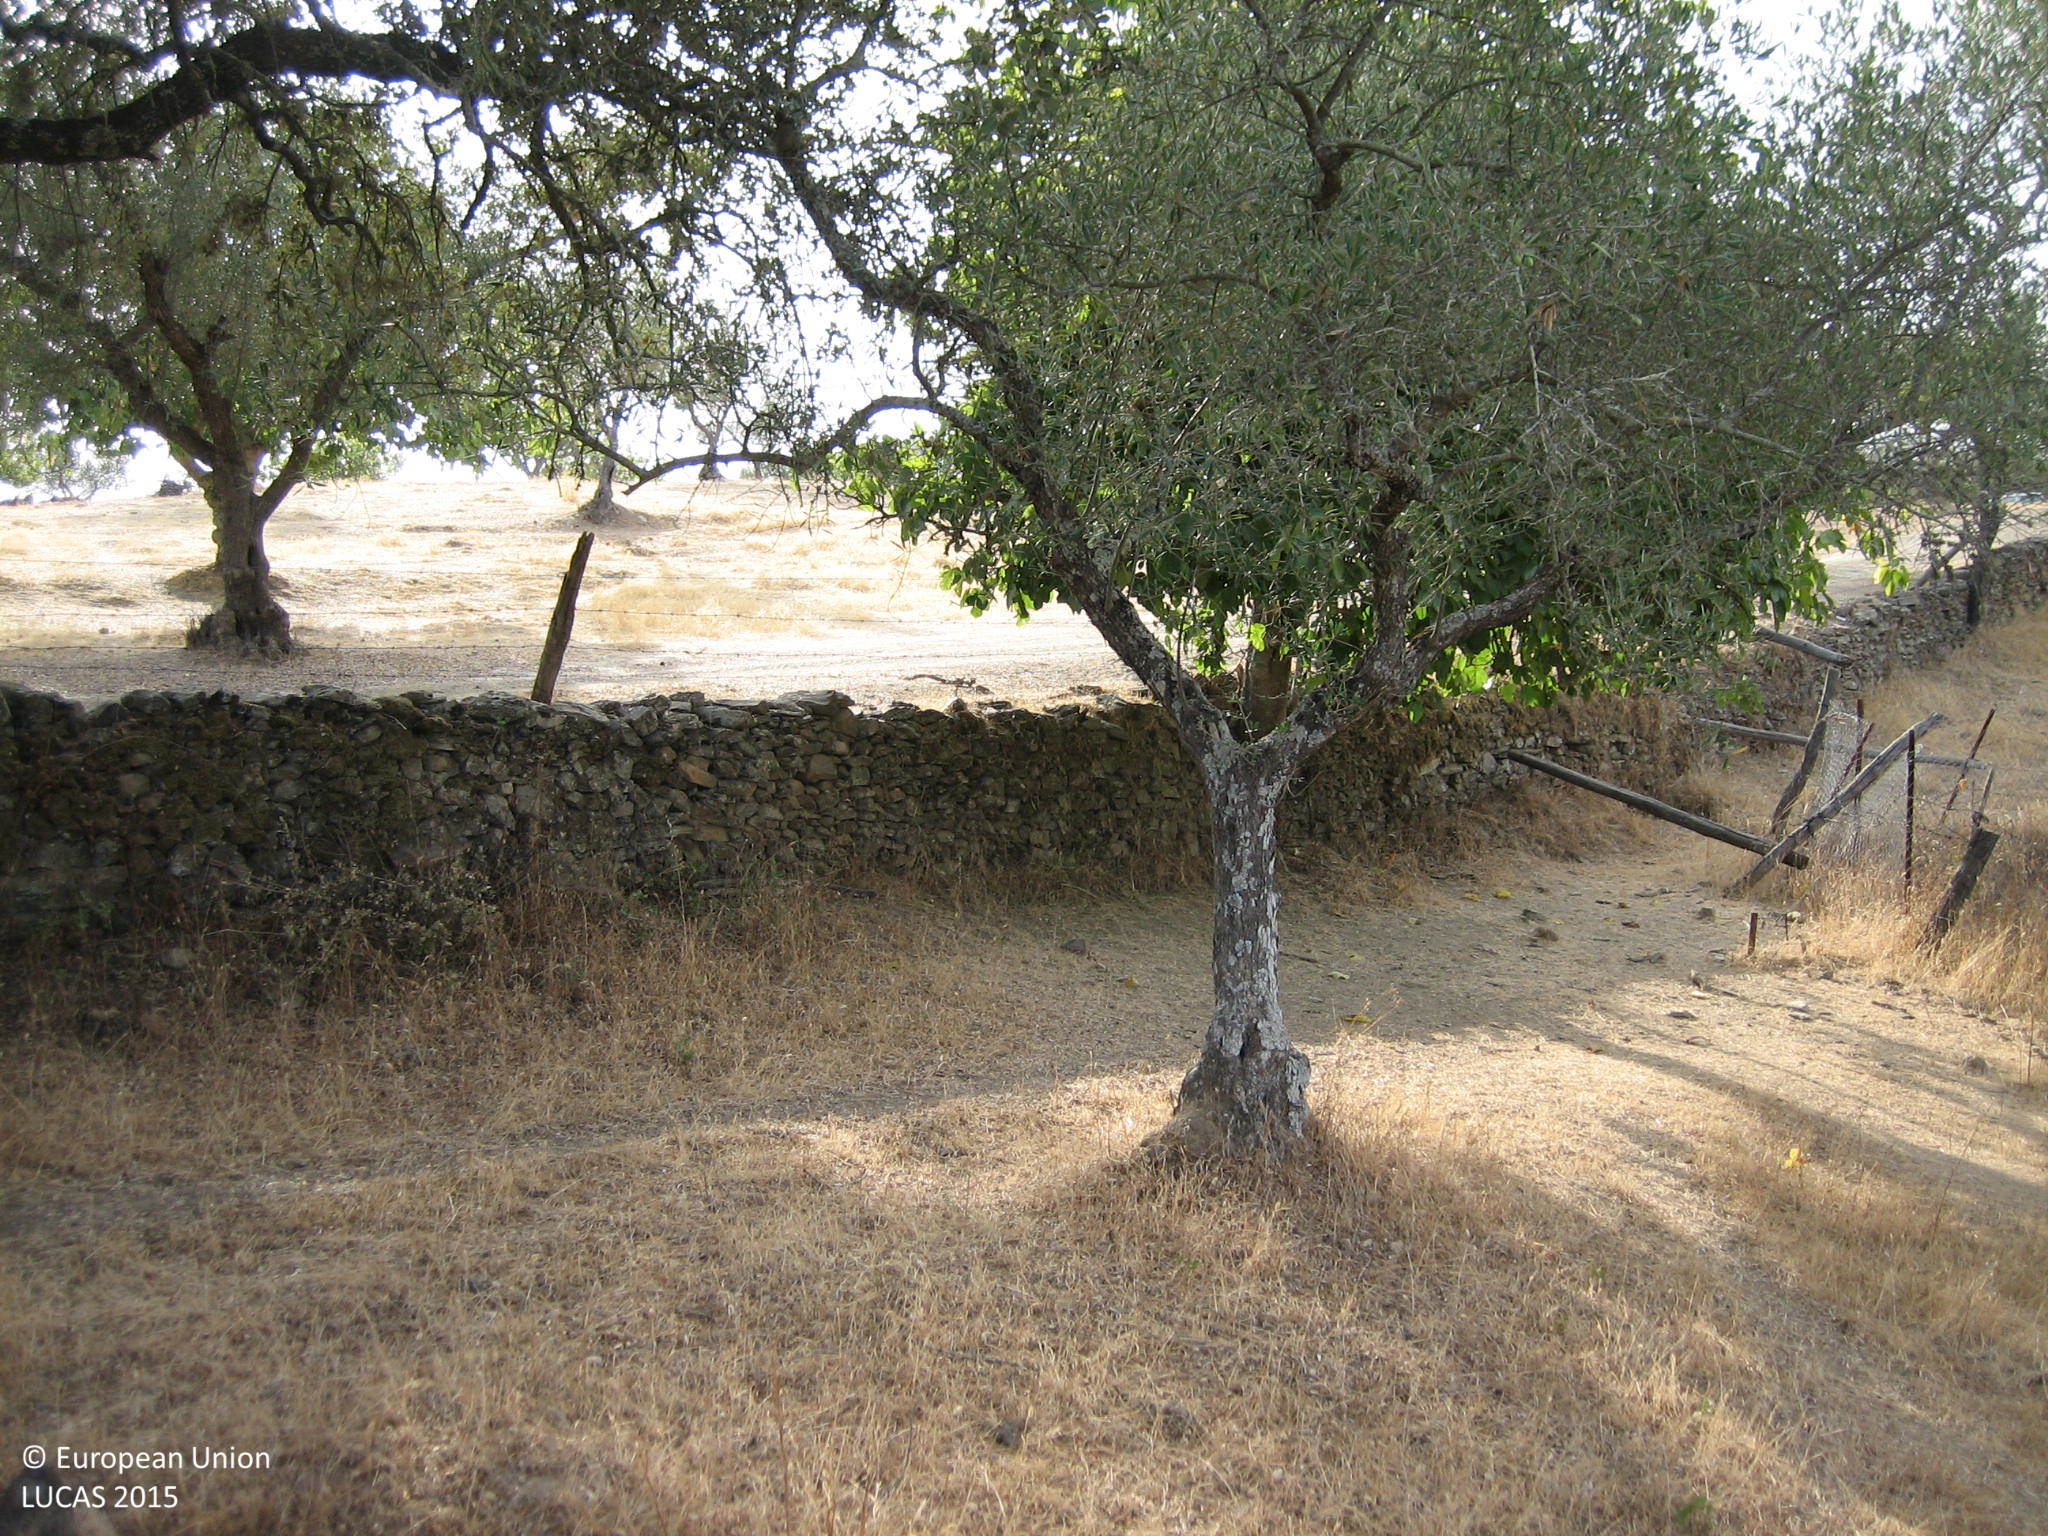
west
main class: Cropland
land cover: Olive groves
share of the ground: 10 - 25 %
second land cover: Grassland without tree/shrub cover
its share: > 75 %
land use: Agriculture (excluding fallow land and kitchen gardens)
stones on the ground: < 10 %
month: September
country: ES
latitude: 38.3112
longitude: -6.7872
